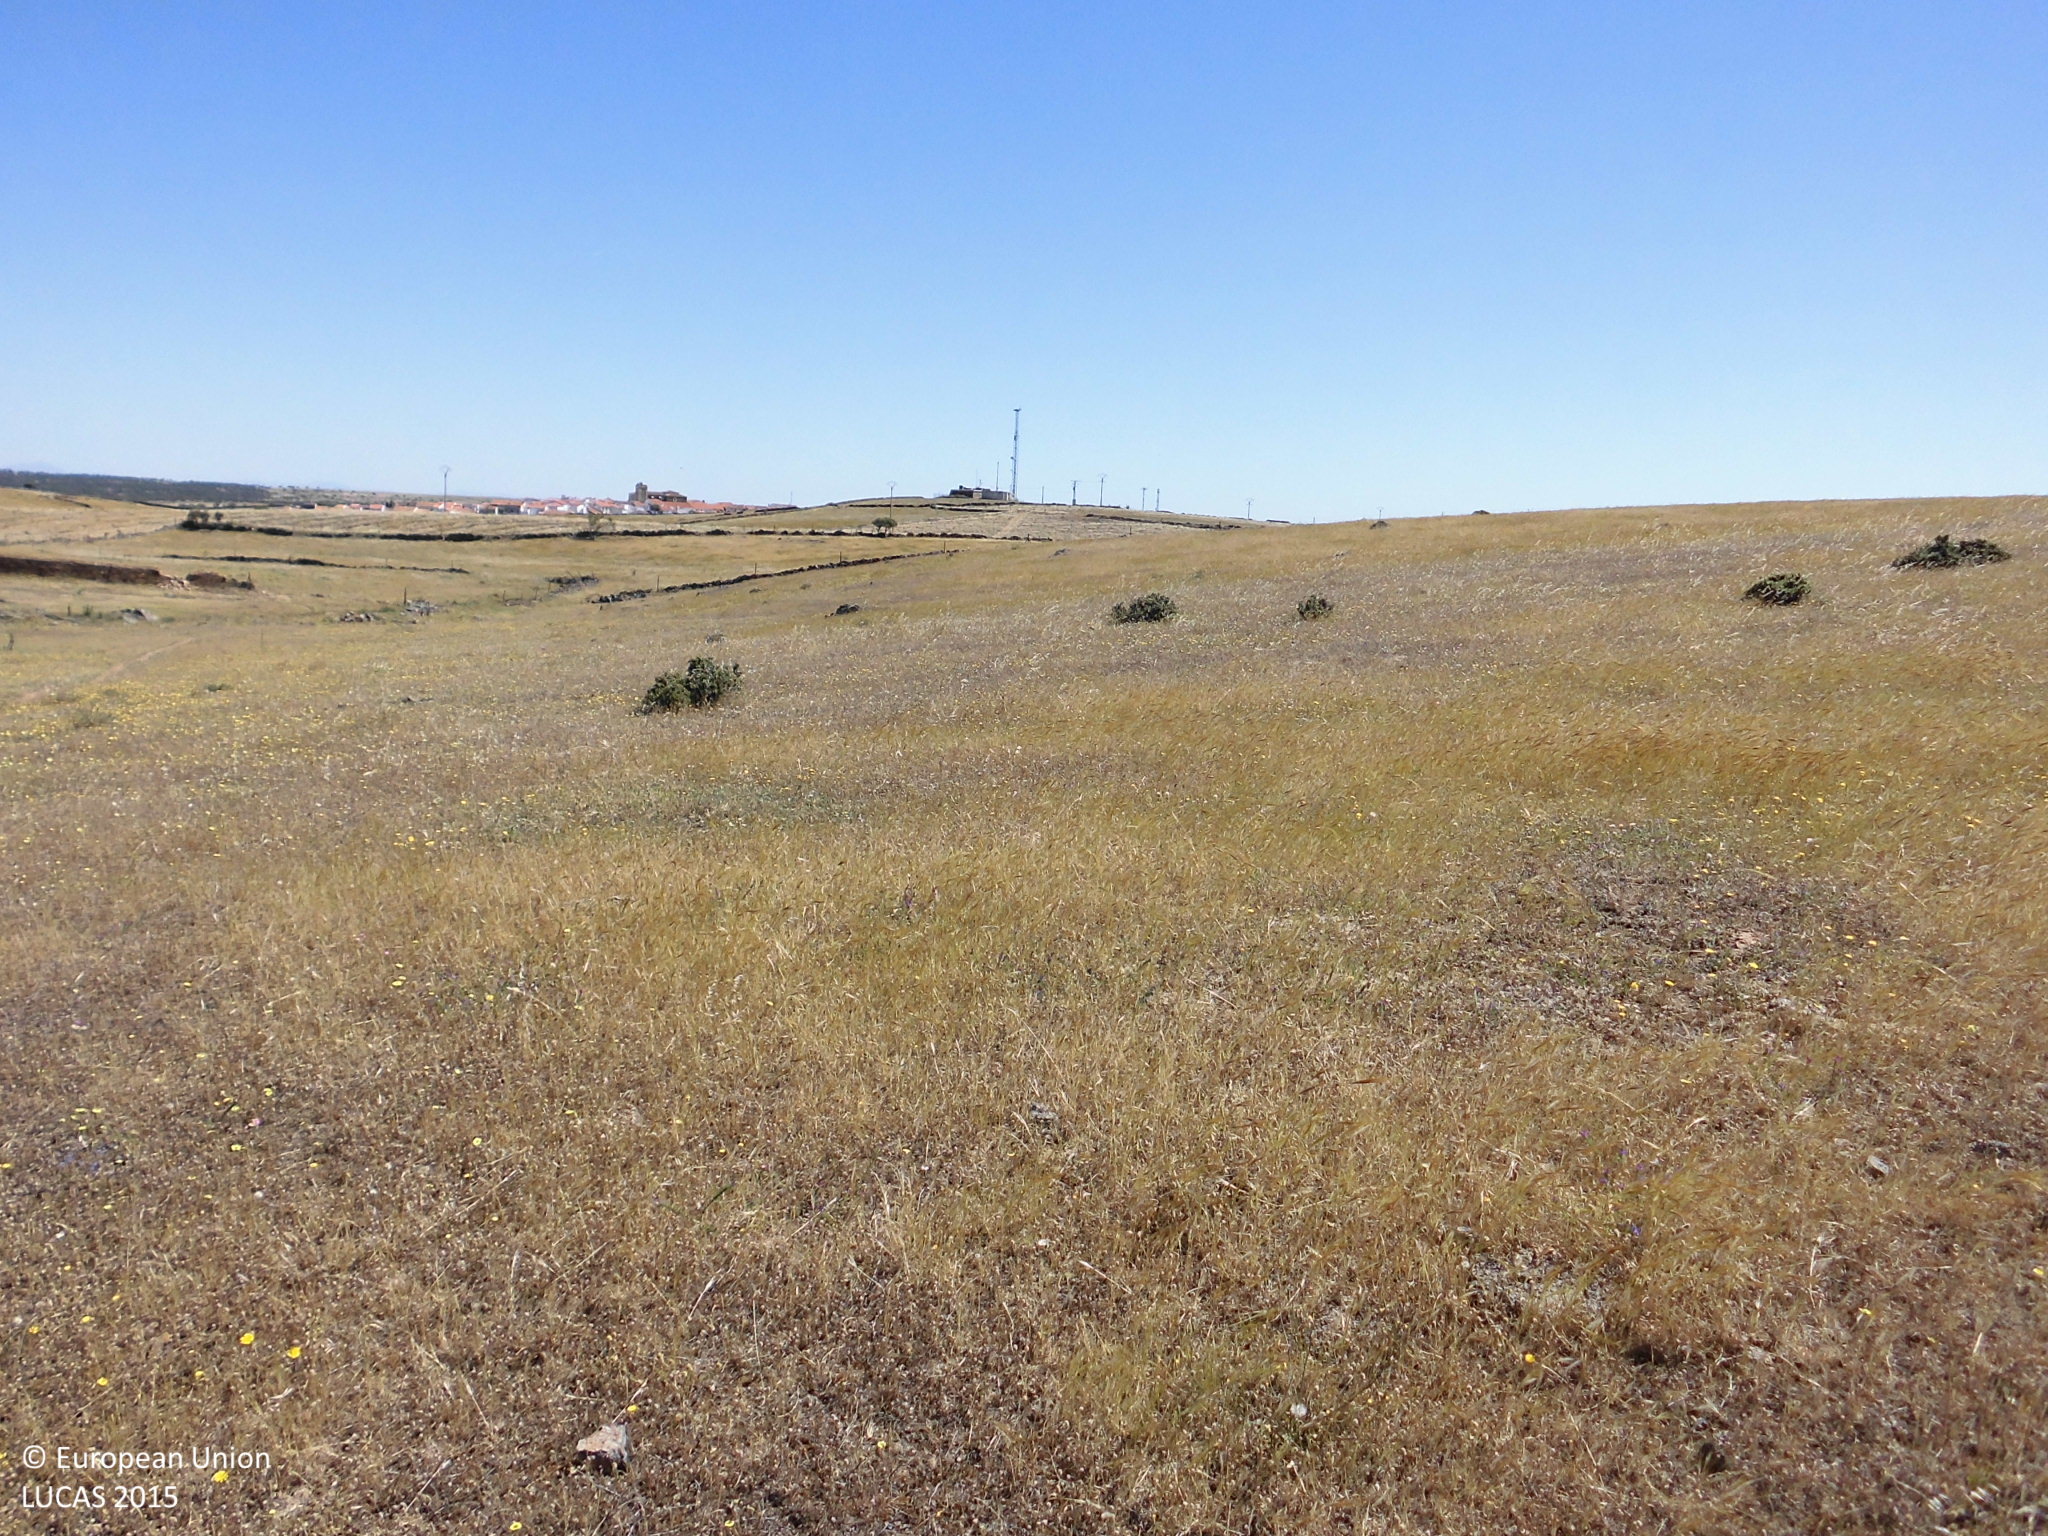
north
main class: Grassland
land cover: Grassland without tree/shrub cover
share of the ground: > 75 %
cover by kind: herbaceous plants 100 %
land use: Agriculture (excluding fallow land and kitchen gardens)
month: May
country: ES
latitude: 39.4691
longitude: -7.0175
